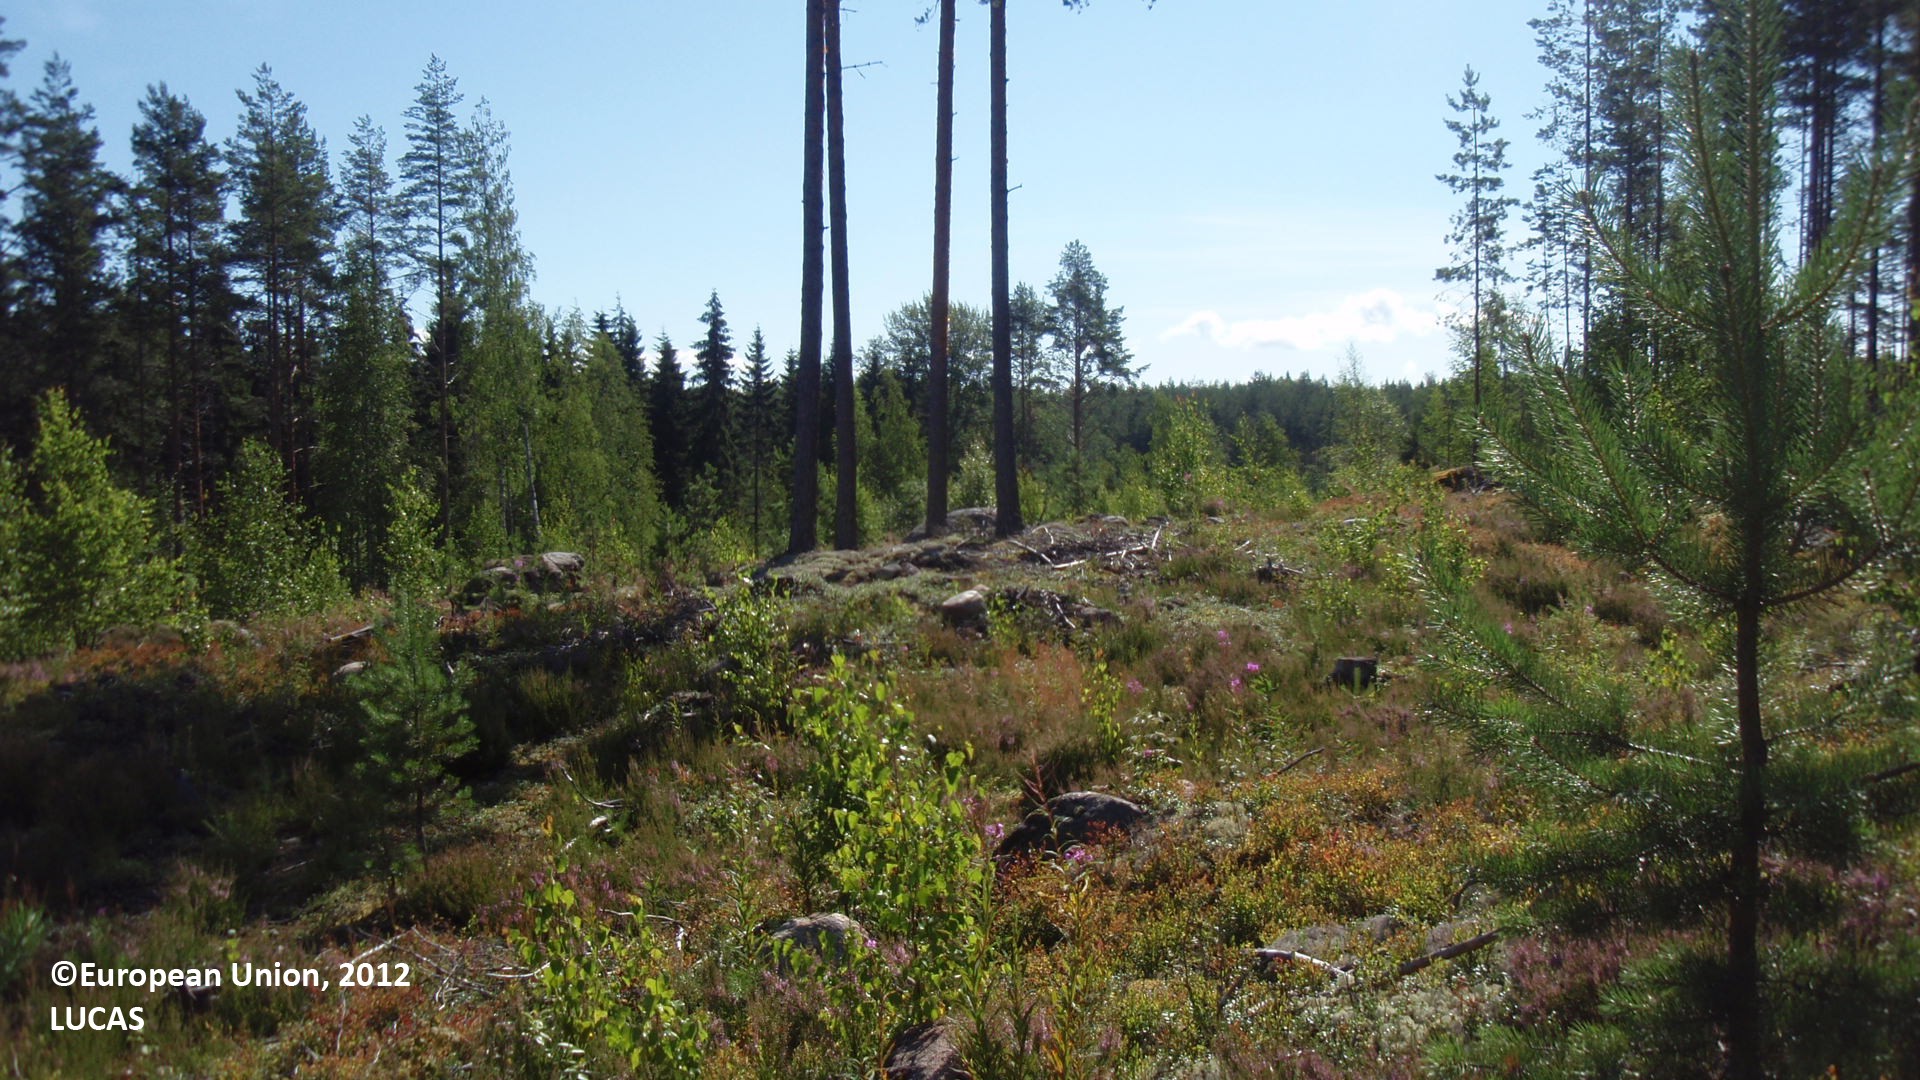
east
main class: Grassland
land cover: Grassland with sparse tree/shrub cover
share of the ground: > 75 %
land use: Forestry
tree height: > 5 m
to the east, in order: Grassland with sparse tree/shrub cover; Lichens and moss; Grassland with sparse tree/shrub cover; Ditches and canals; Shruby margins; Paved roads, cycling and walking lanes; Shruby margins; Grassland with sparse tree/shrub cover; Spruce dominated coniferous woodland; Broadleaved woodland; Ditches and canals; Broadleaved woodland
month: July
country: FI
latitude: 61.4212
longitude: 28.1332
